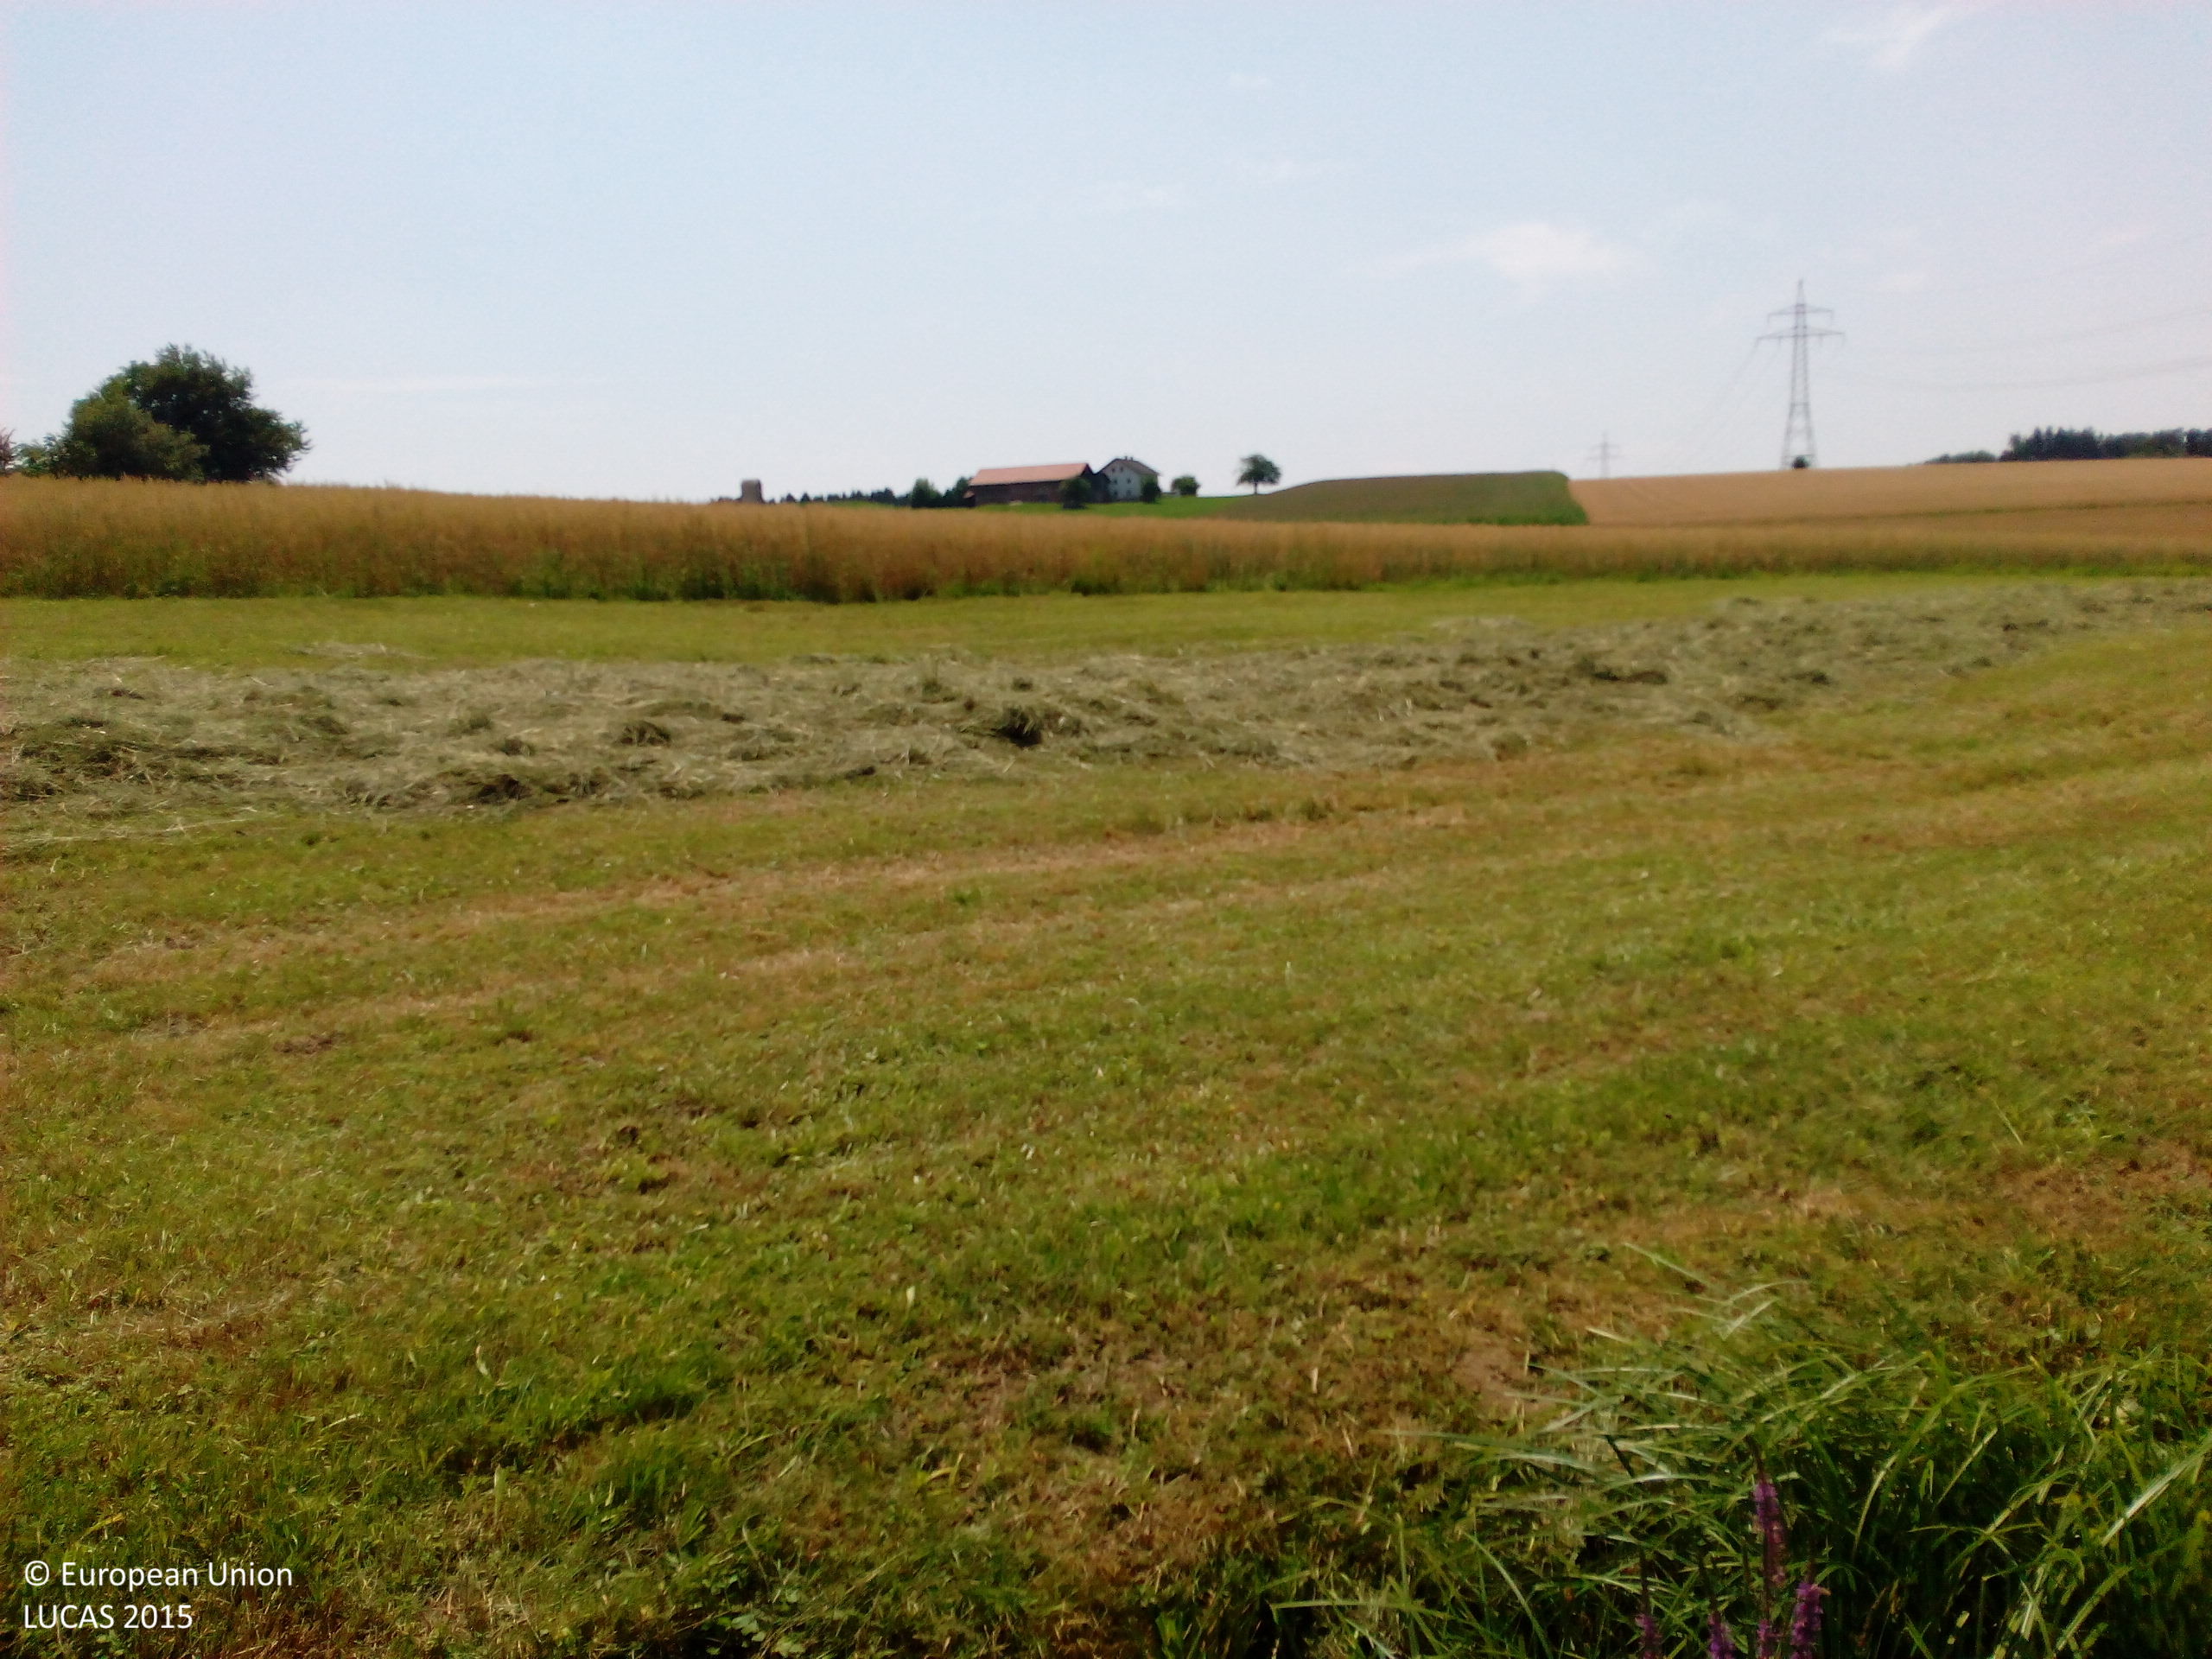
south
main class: Grassland
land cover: Grassland without tree/shrub cover
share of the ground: 50 - 75 %
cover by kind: herbaceous plants 70 %, unconsolidated bare surface 30 %
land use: Agriculture (excluding fallow land and kitchen gardens)
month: July
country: DE
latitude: 48.4733
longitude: 12.9074
